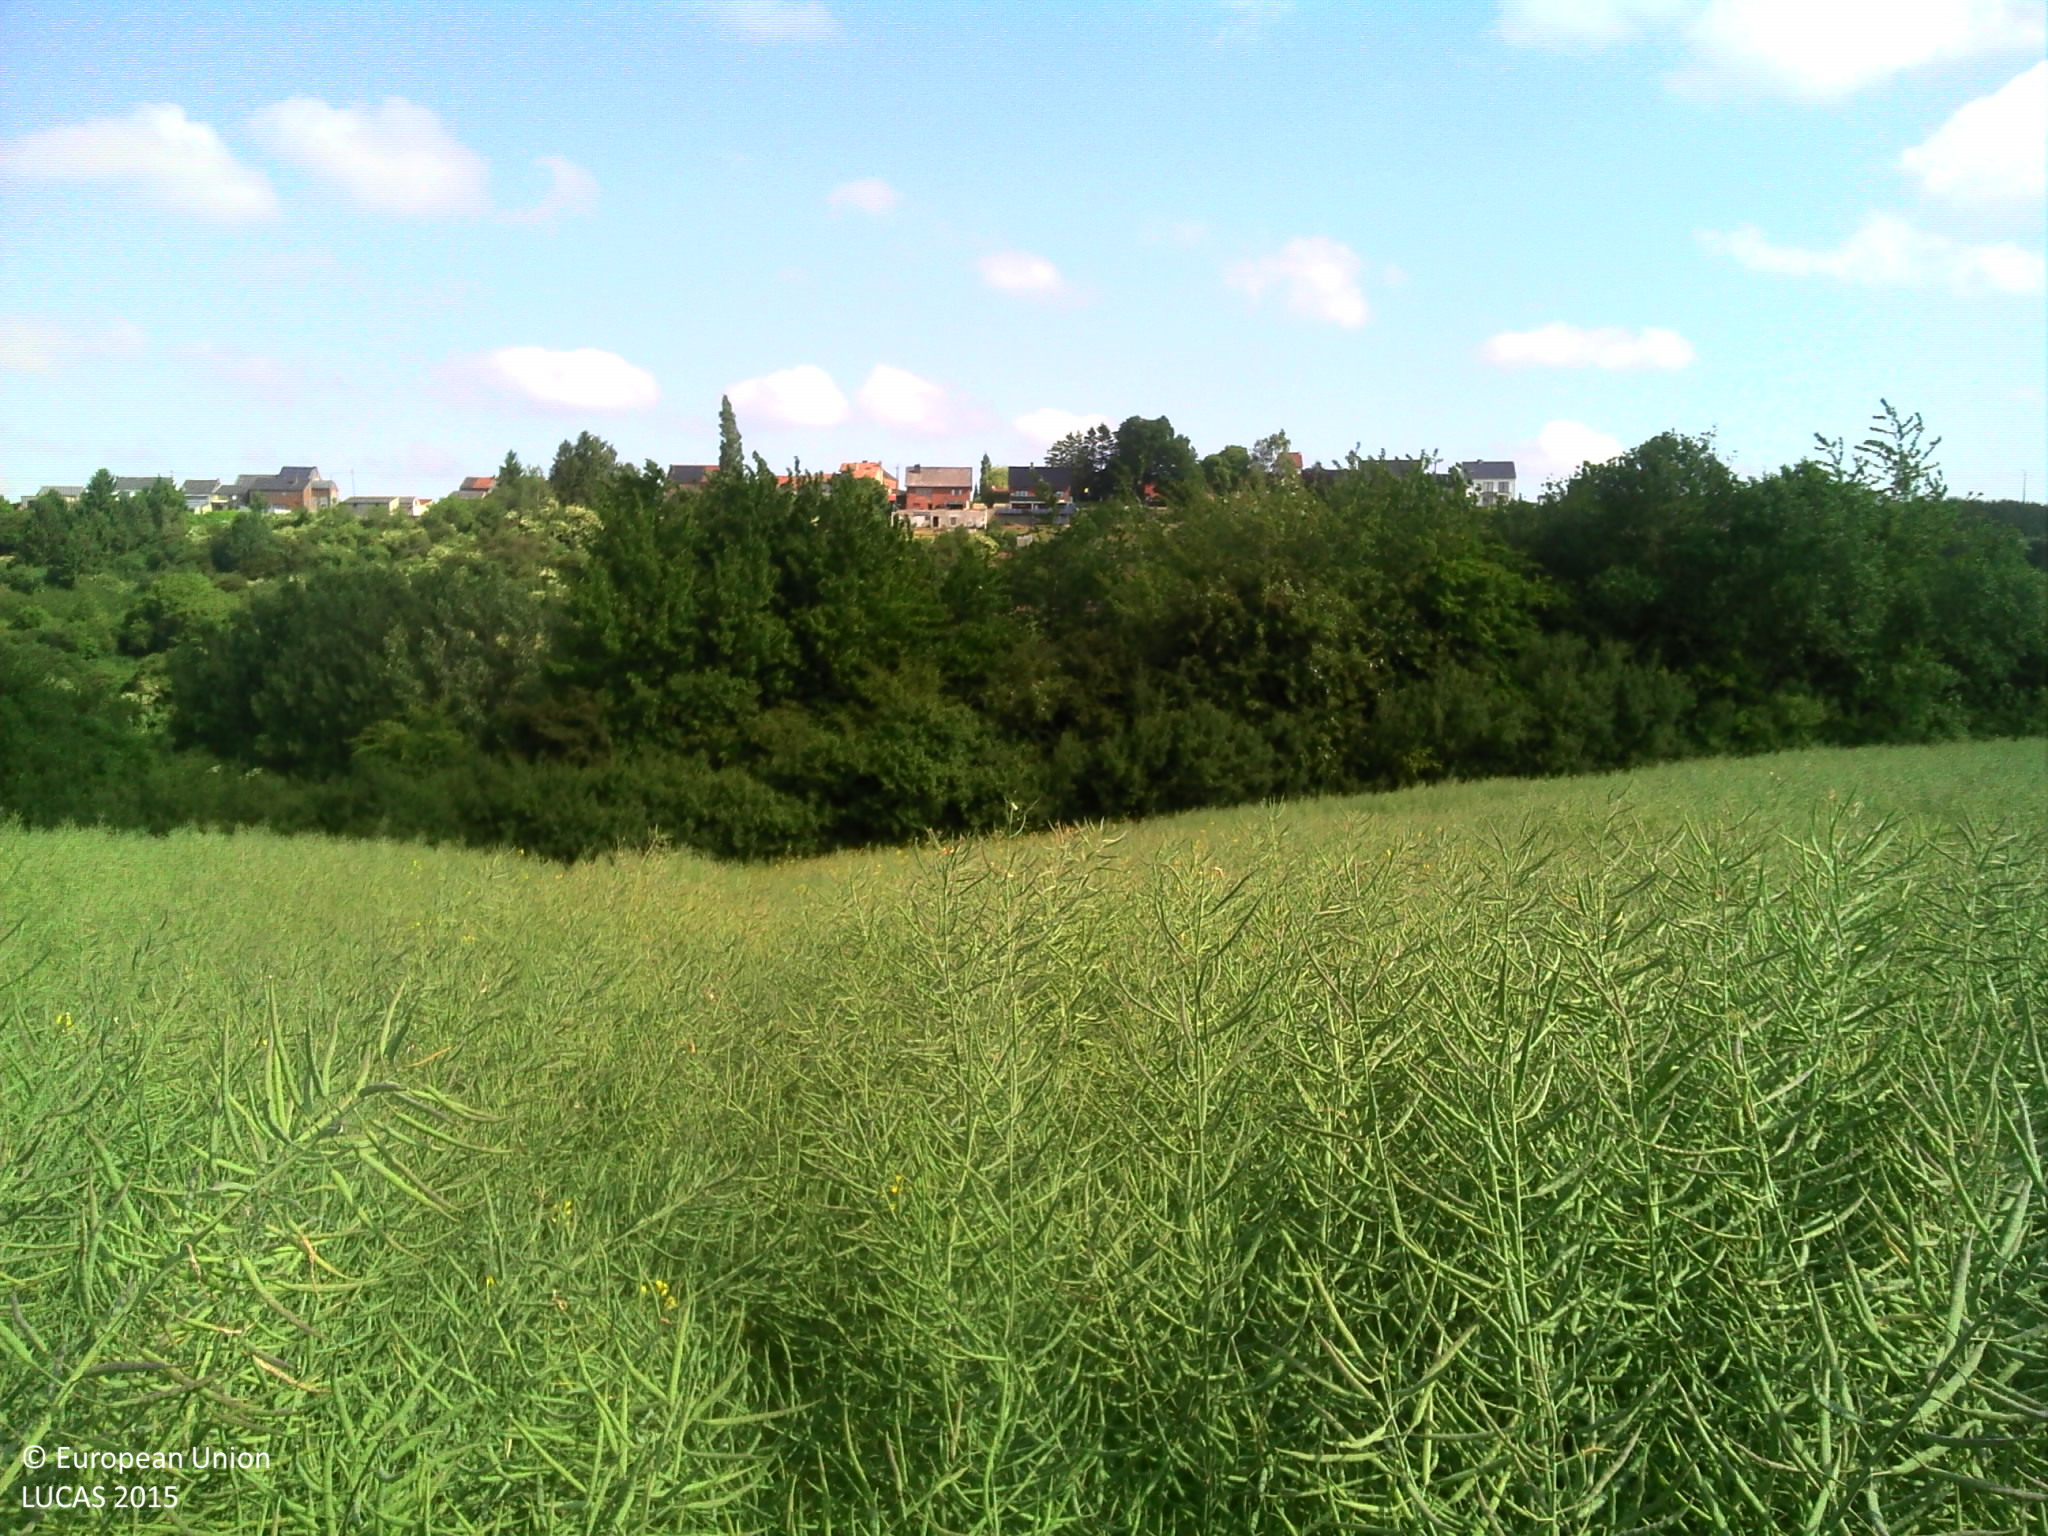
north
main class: Cropland
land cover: Rape and turnip rape
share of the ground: > 75 %
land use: Agriculture (excluding fallow land and kitchen gardens)
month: June
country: BE
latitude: 50.4017
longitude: 4.6641
